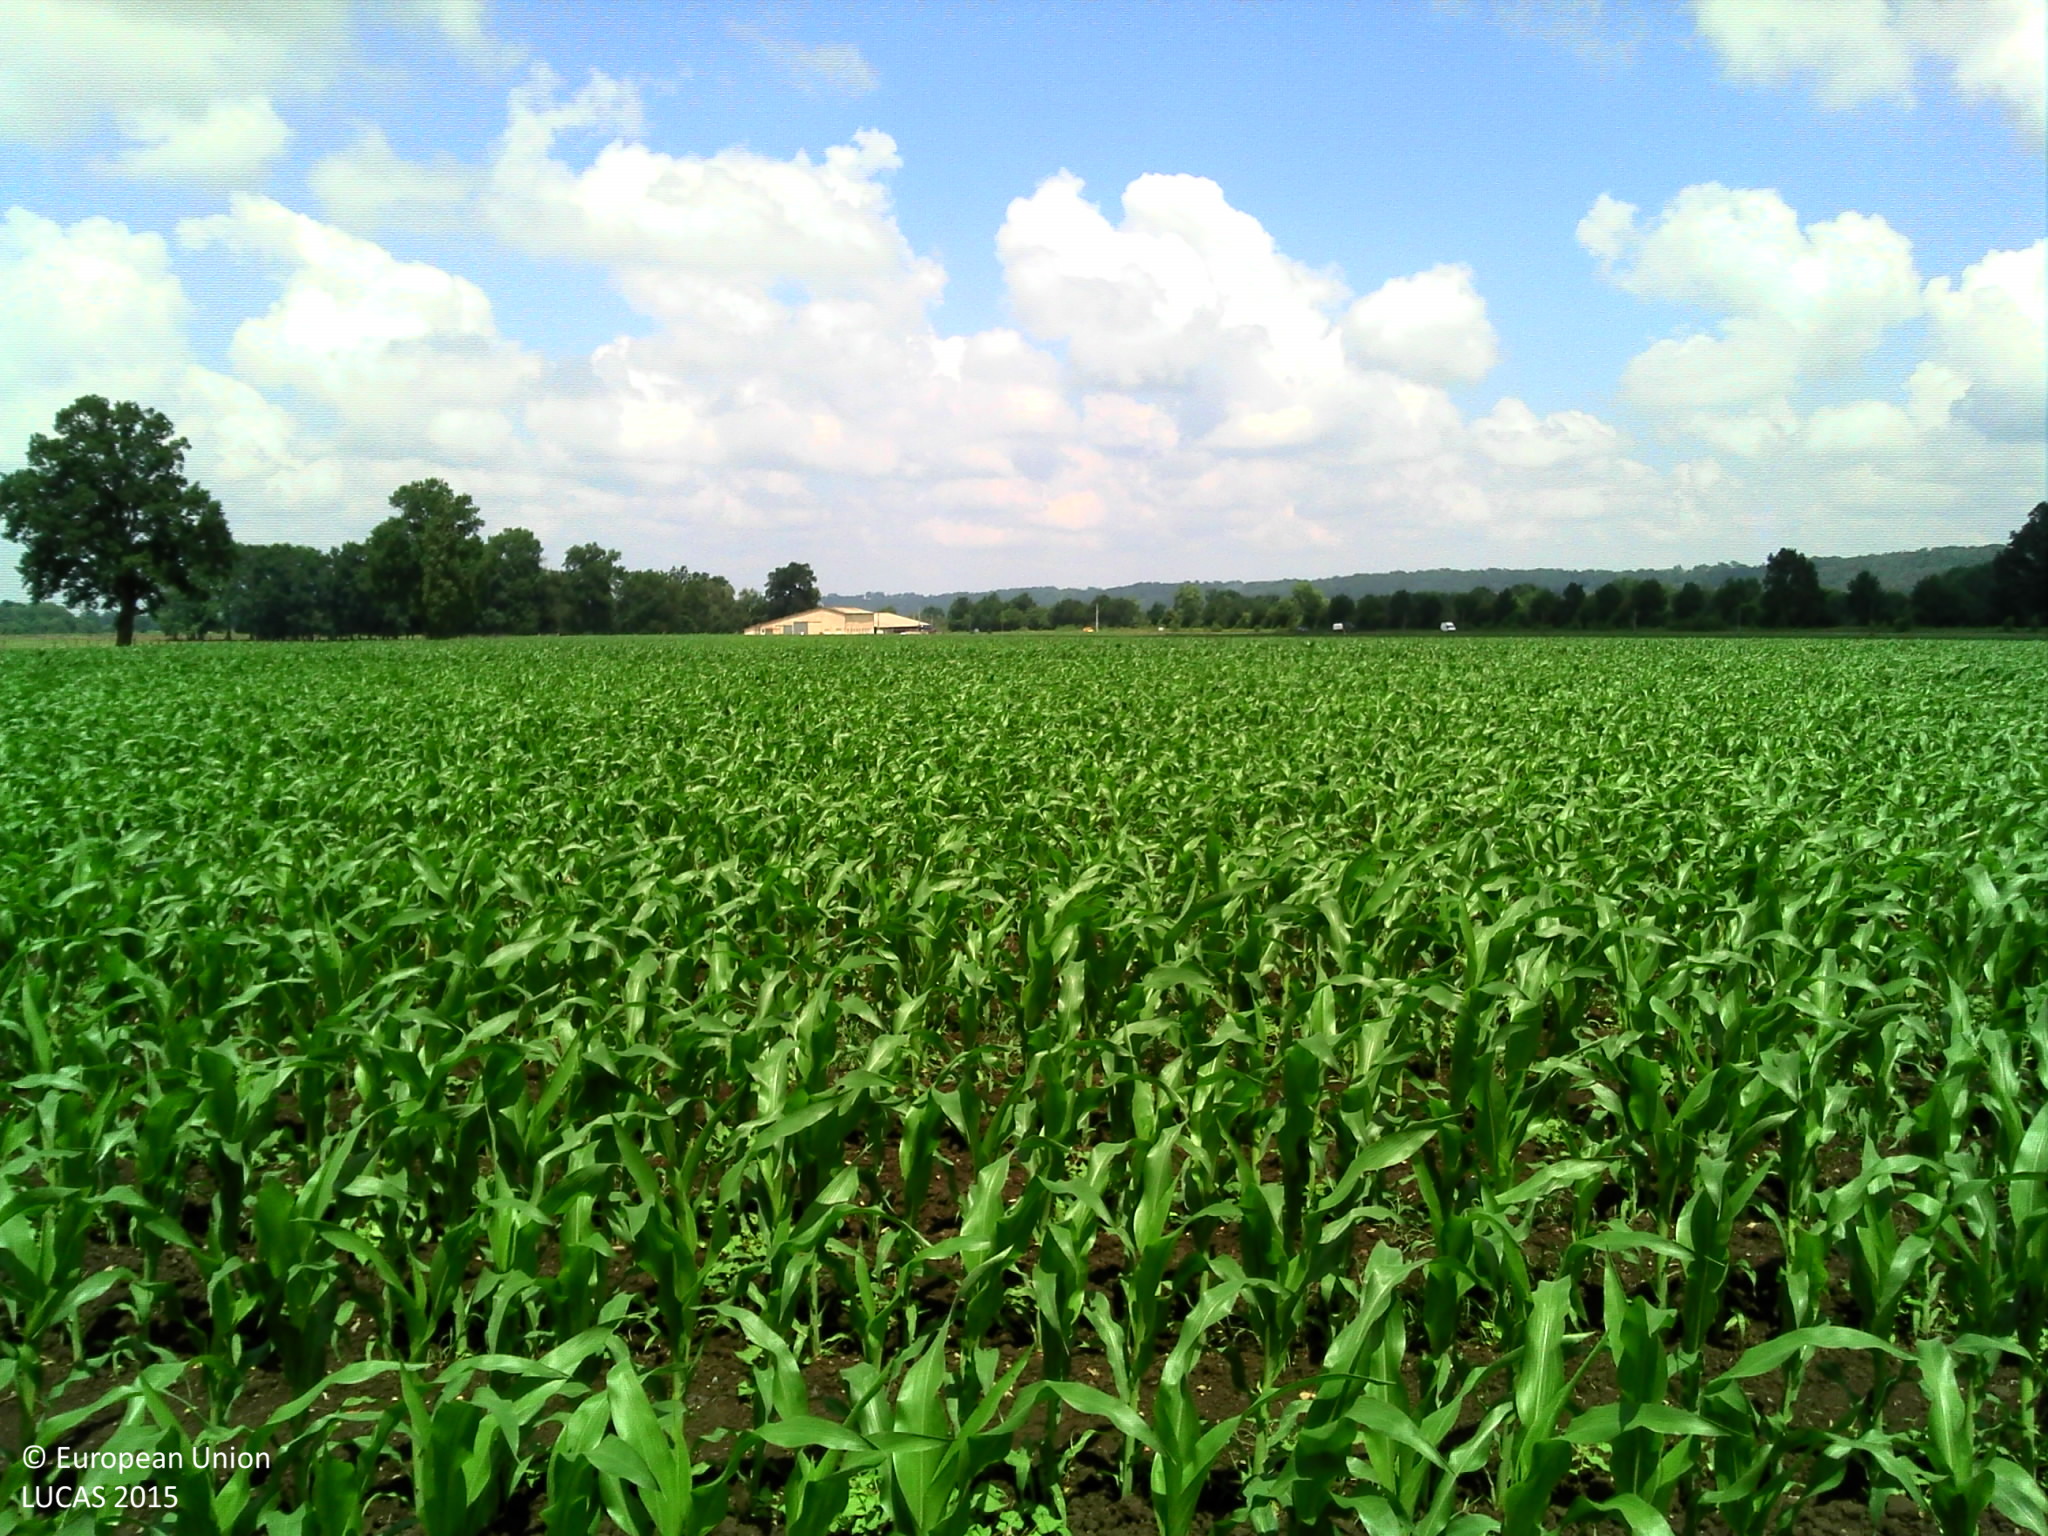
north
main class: Cropland
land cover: Maize
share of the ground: 25 - 50 %
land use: Agriculture (excluding fallow land and kitchen gardens)
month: June
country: FR
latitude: 43.1992
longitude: -0.1326
